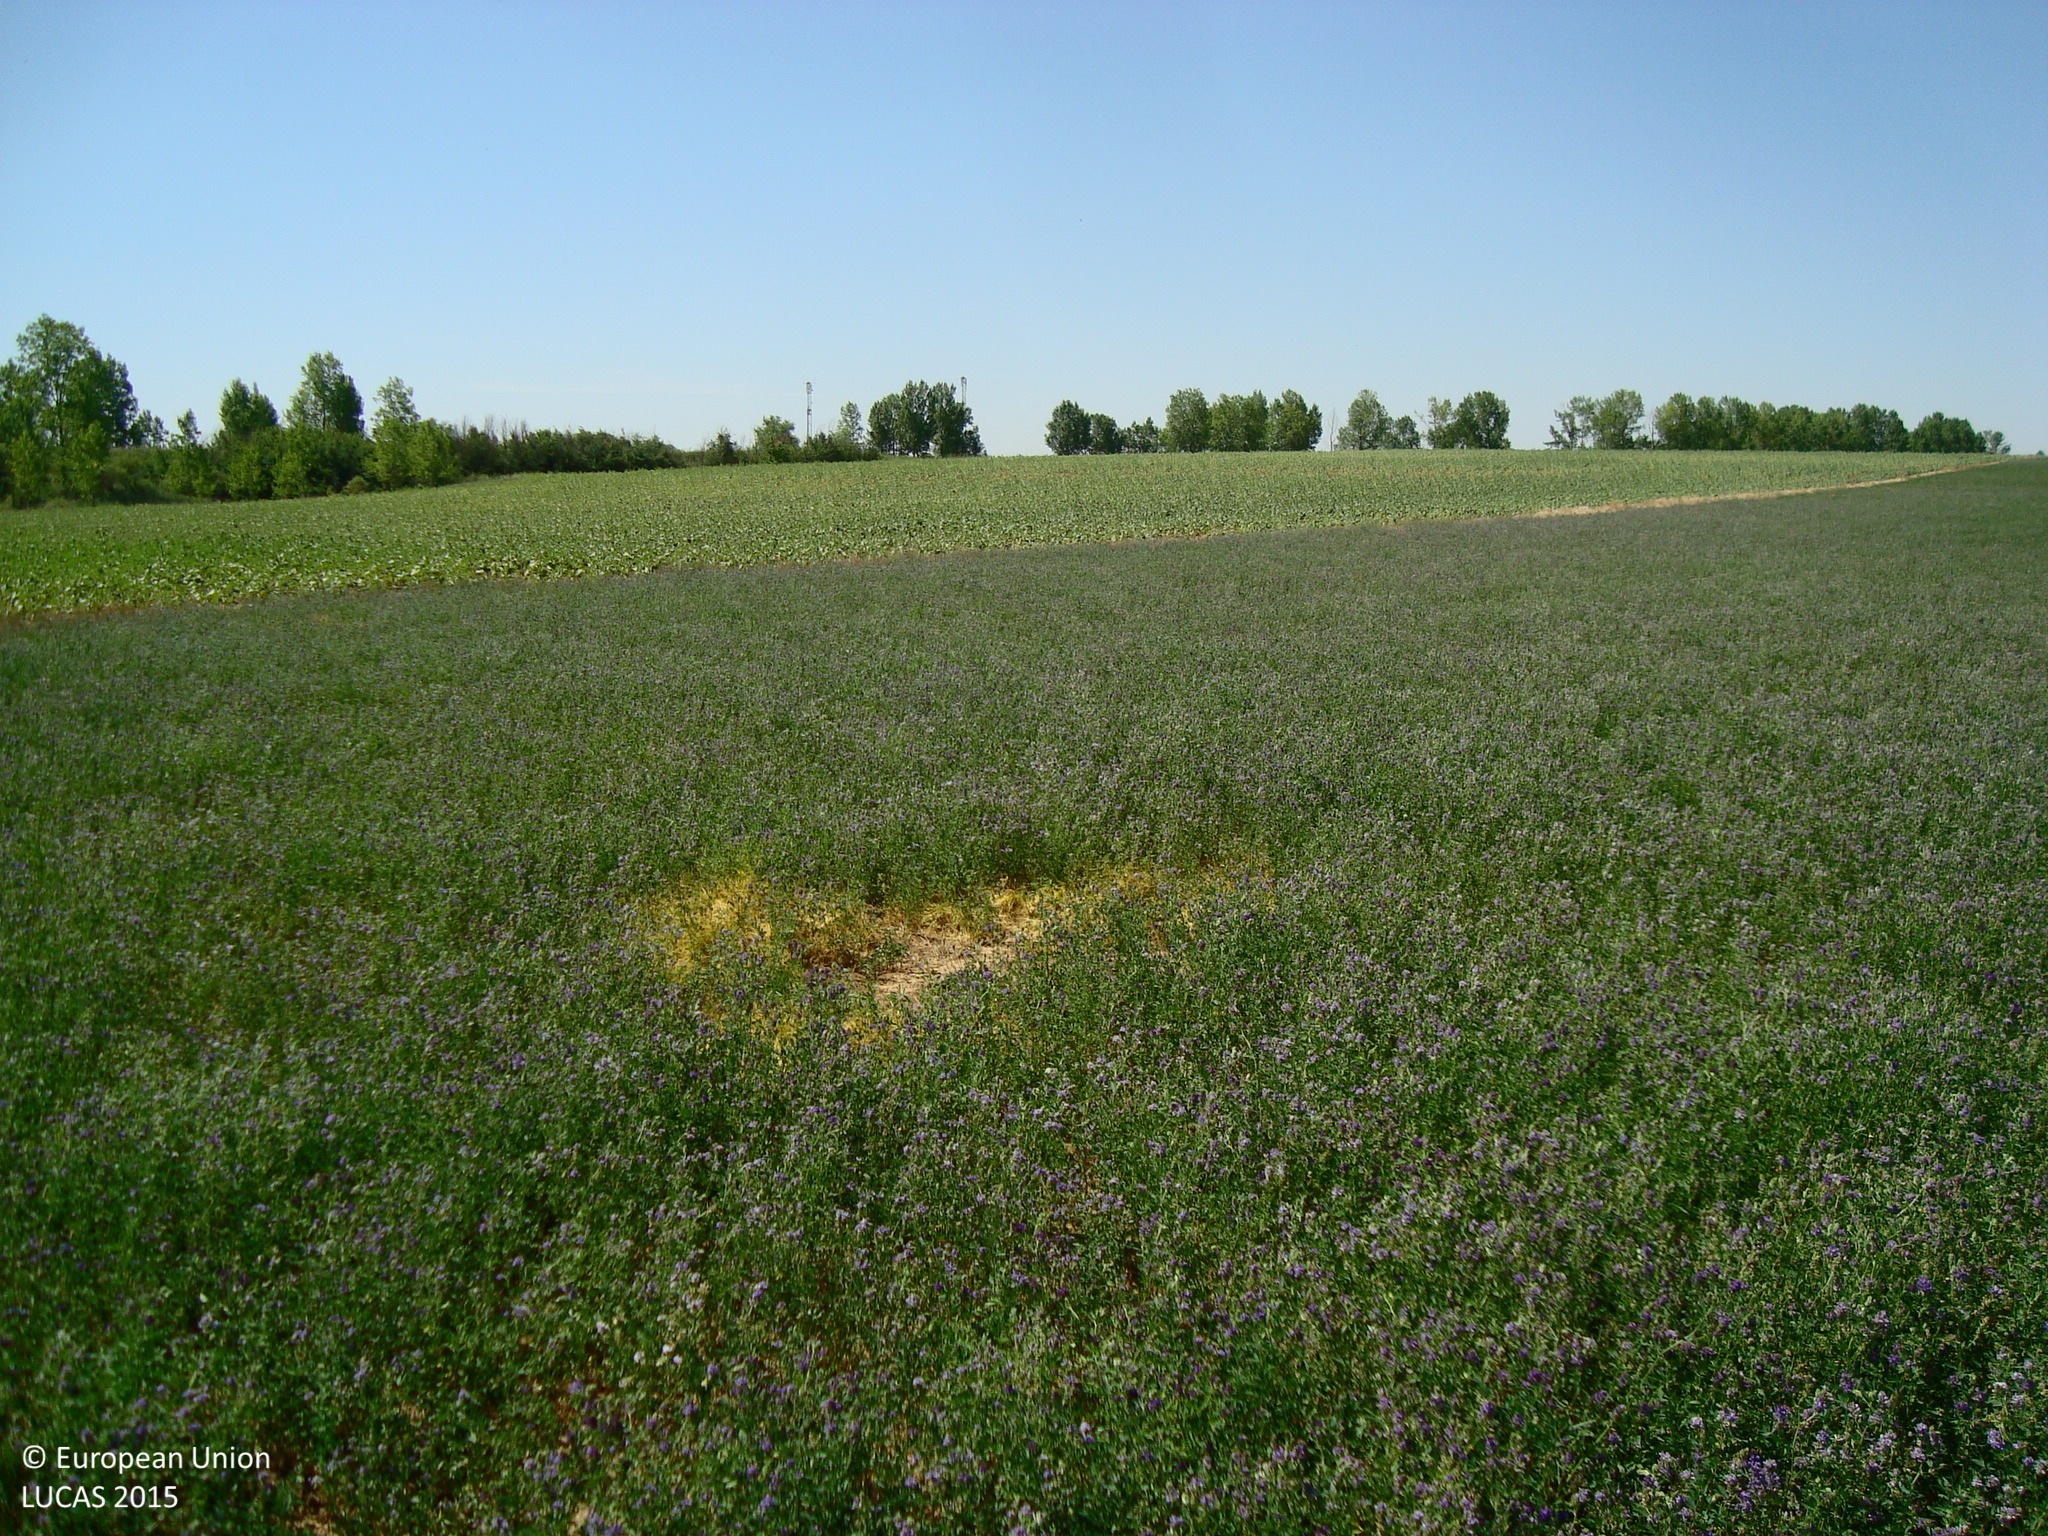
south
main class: Cropland
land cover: Lucerne
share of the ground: > 75 %
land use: Agriculture (excluding fallow land and kitchen gardens)
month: July
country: ES
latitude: 42.0930
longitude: -4.7898
